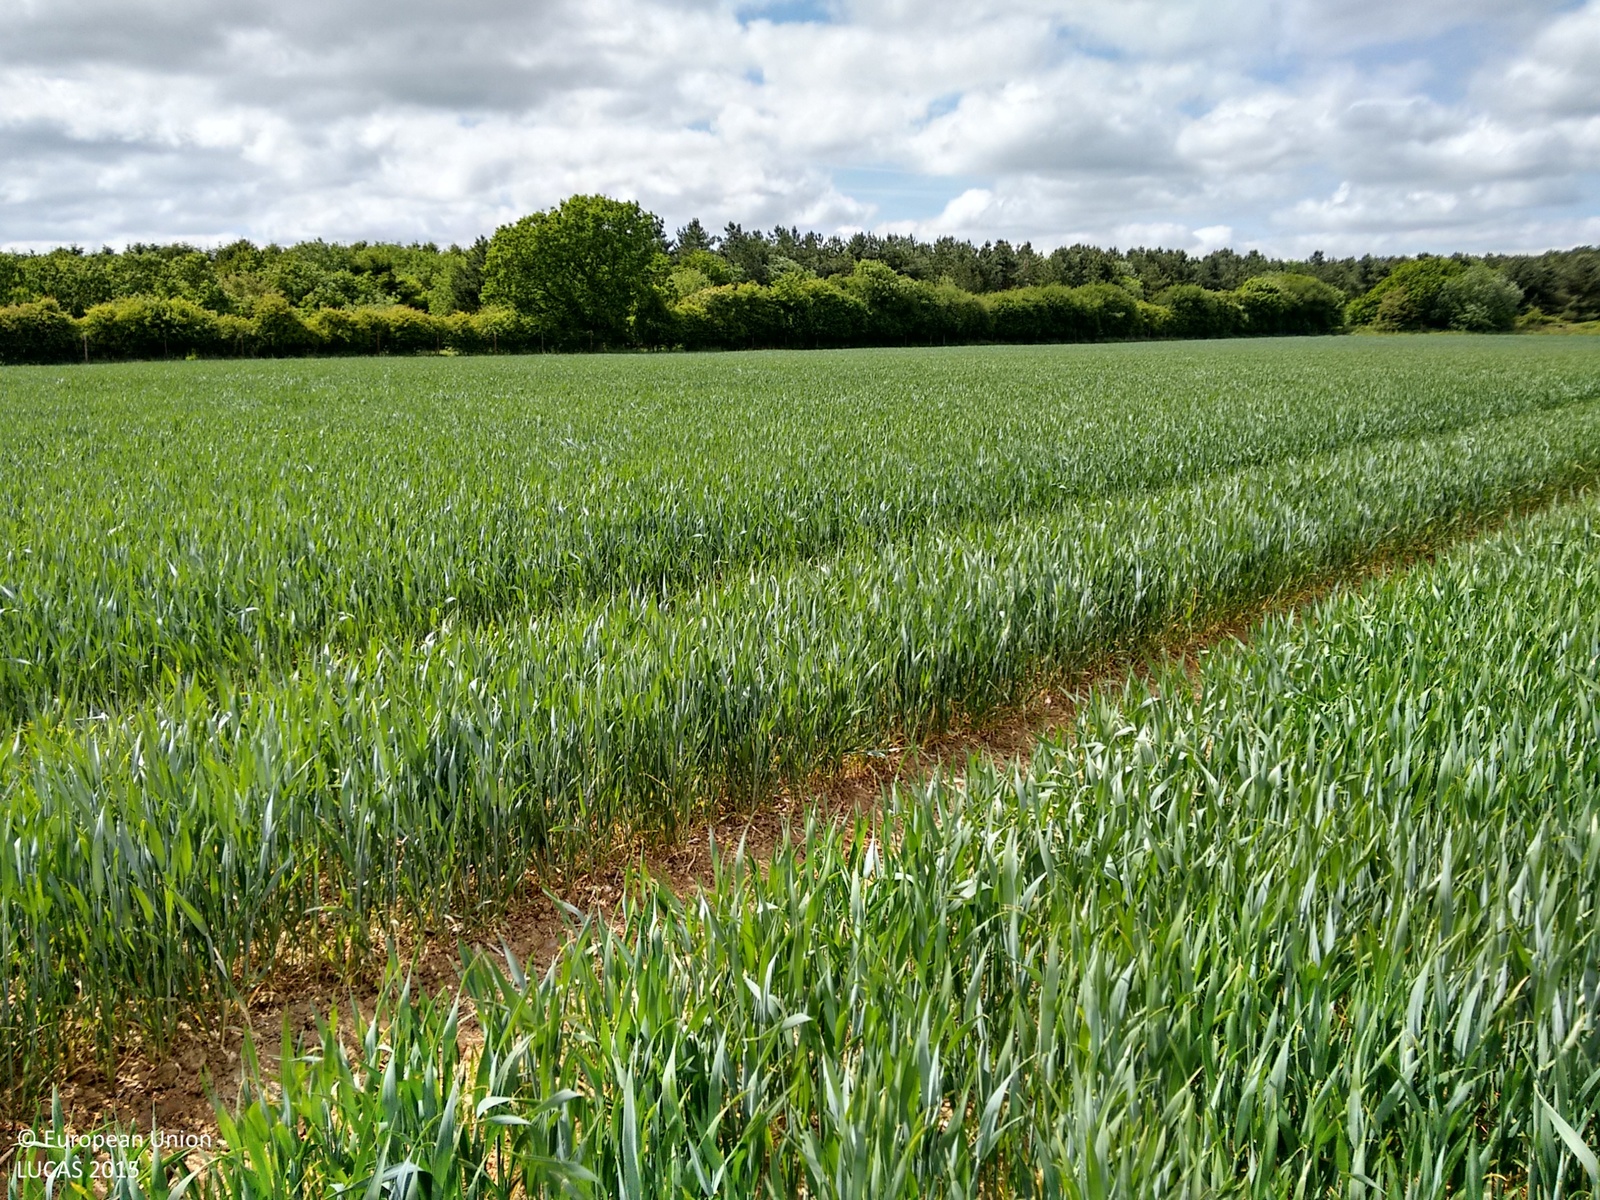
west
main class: Cropland
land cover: Common wheat
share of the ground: > 75 %
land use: Agriculture (excluding fallow land and kitchen gardens)
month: June
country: GB
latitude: 52.7918
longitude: -0.5825
